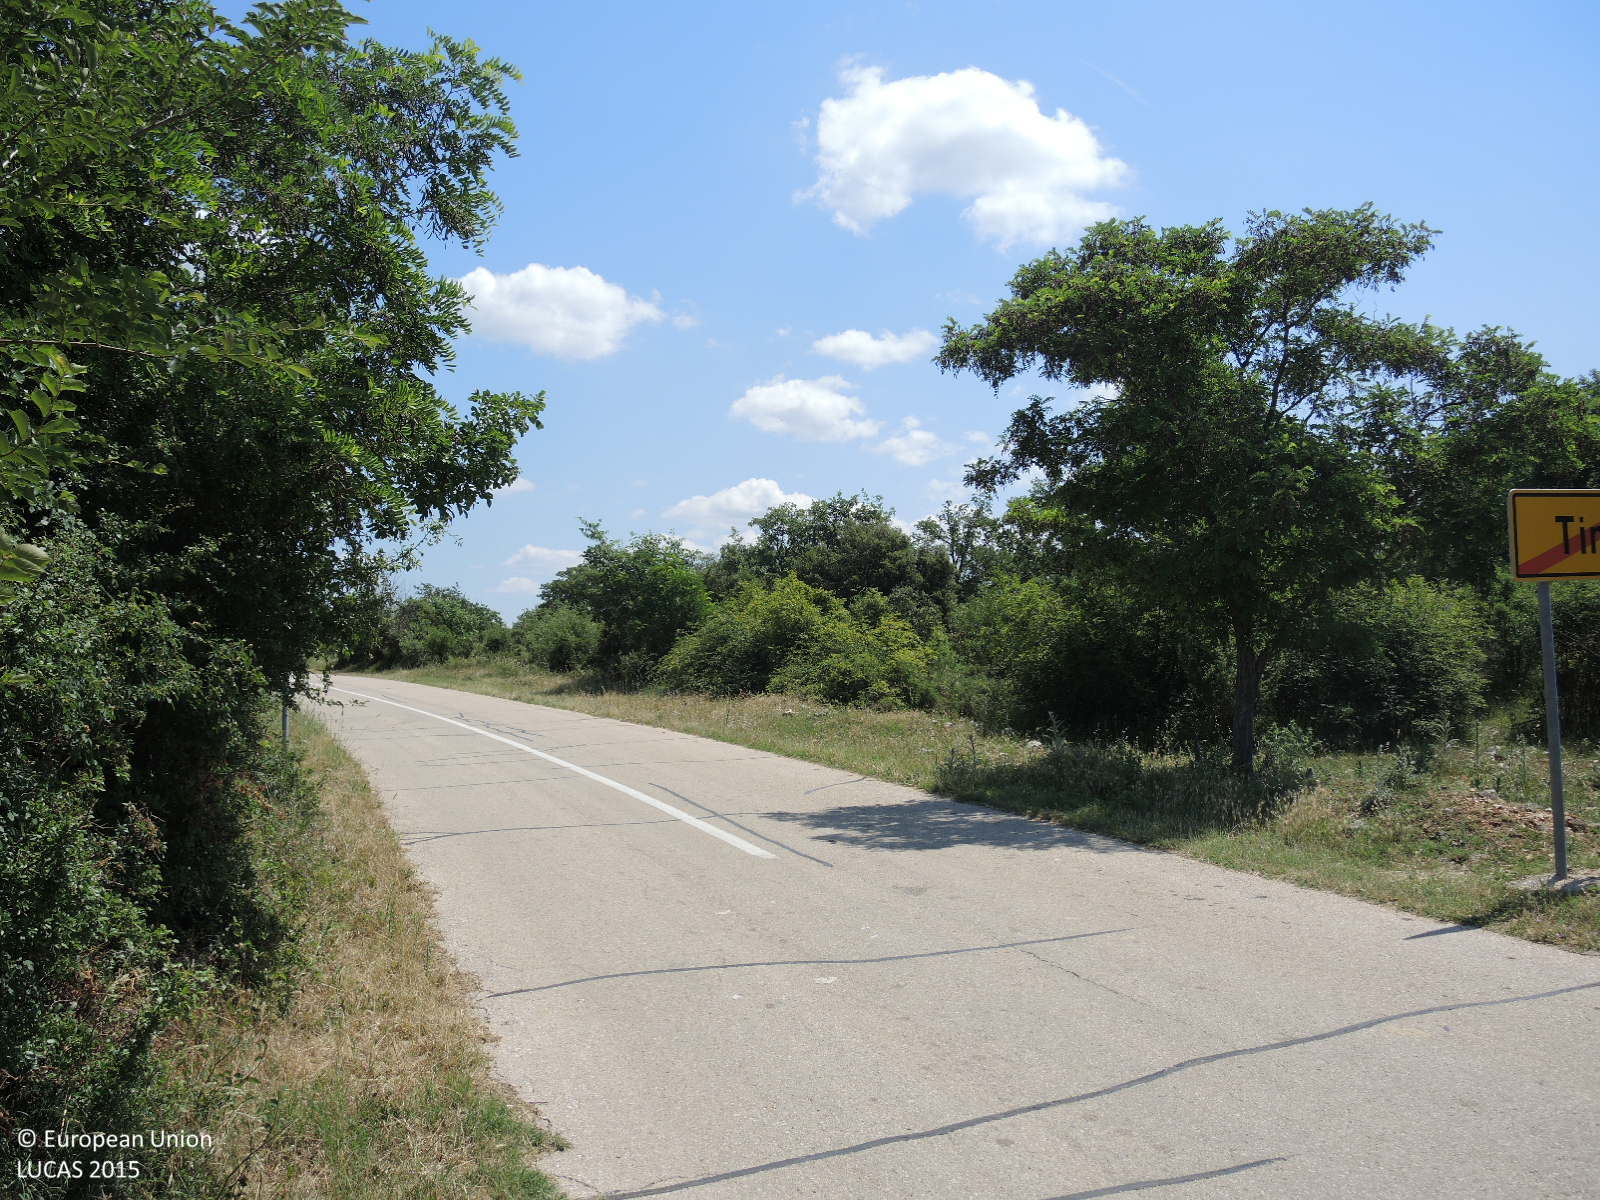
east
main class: Woodland
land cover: Broadleaved woodland
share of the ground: 25 - 50 %
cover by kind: broadleaved forest trees 45 %, herbaceous plants 25 %, shrubs 10 %, consolidated bare surface 10 %, unconsolidated bare surface 10 %
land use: Semi-natural and natural areas not in use
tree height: < 5 m
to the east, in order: Broadleaved woodland; Fences; Grass margins; Paved roads, cycling and walking lanes; Other coniferous woodland; Shrubland with sparse tree cover; Shrubland without tree cover
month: May
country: HR
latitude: 44.0256
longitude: 15.4688
